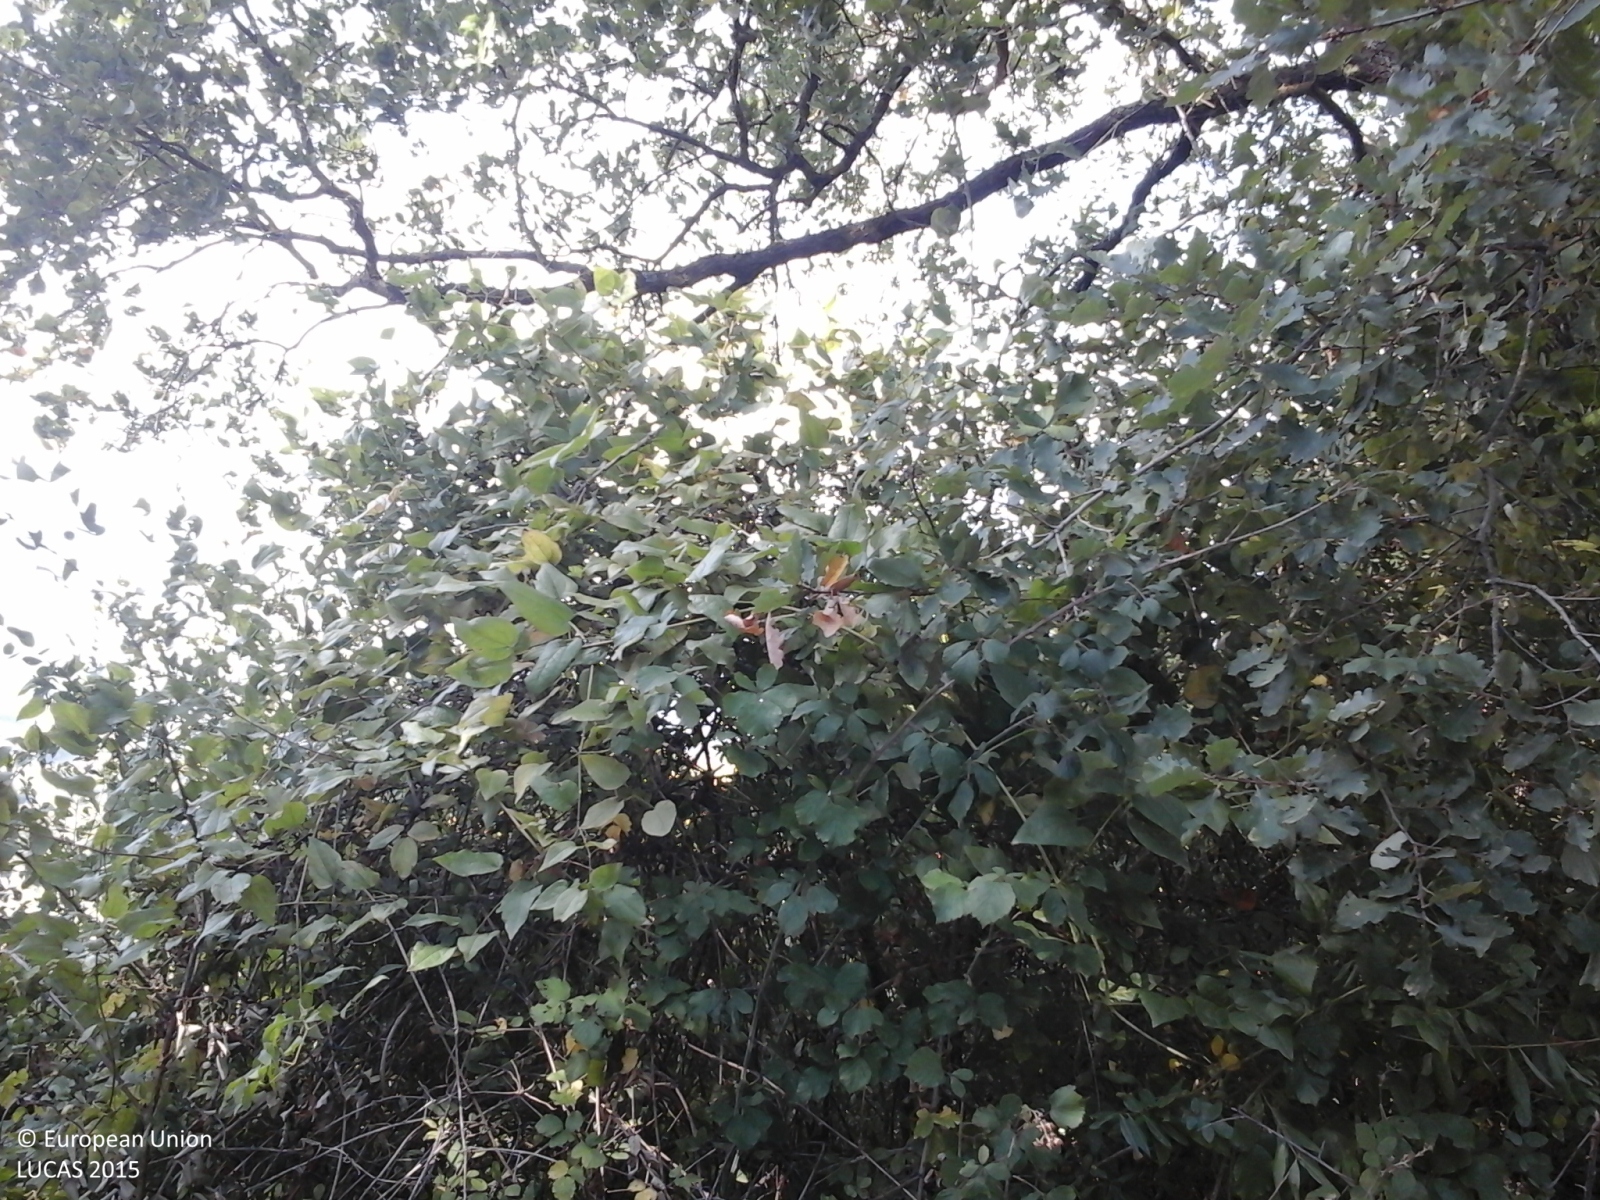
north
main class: Grassland
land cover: Grassland without tree/shrub cover
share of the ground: > 75 %
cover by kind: herbaceous plants 100 %
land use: Agriculture (excluding fallow land and kitchen gardens)
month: September
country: IT
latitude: 43.2082
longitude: 12.1969
